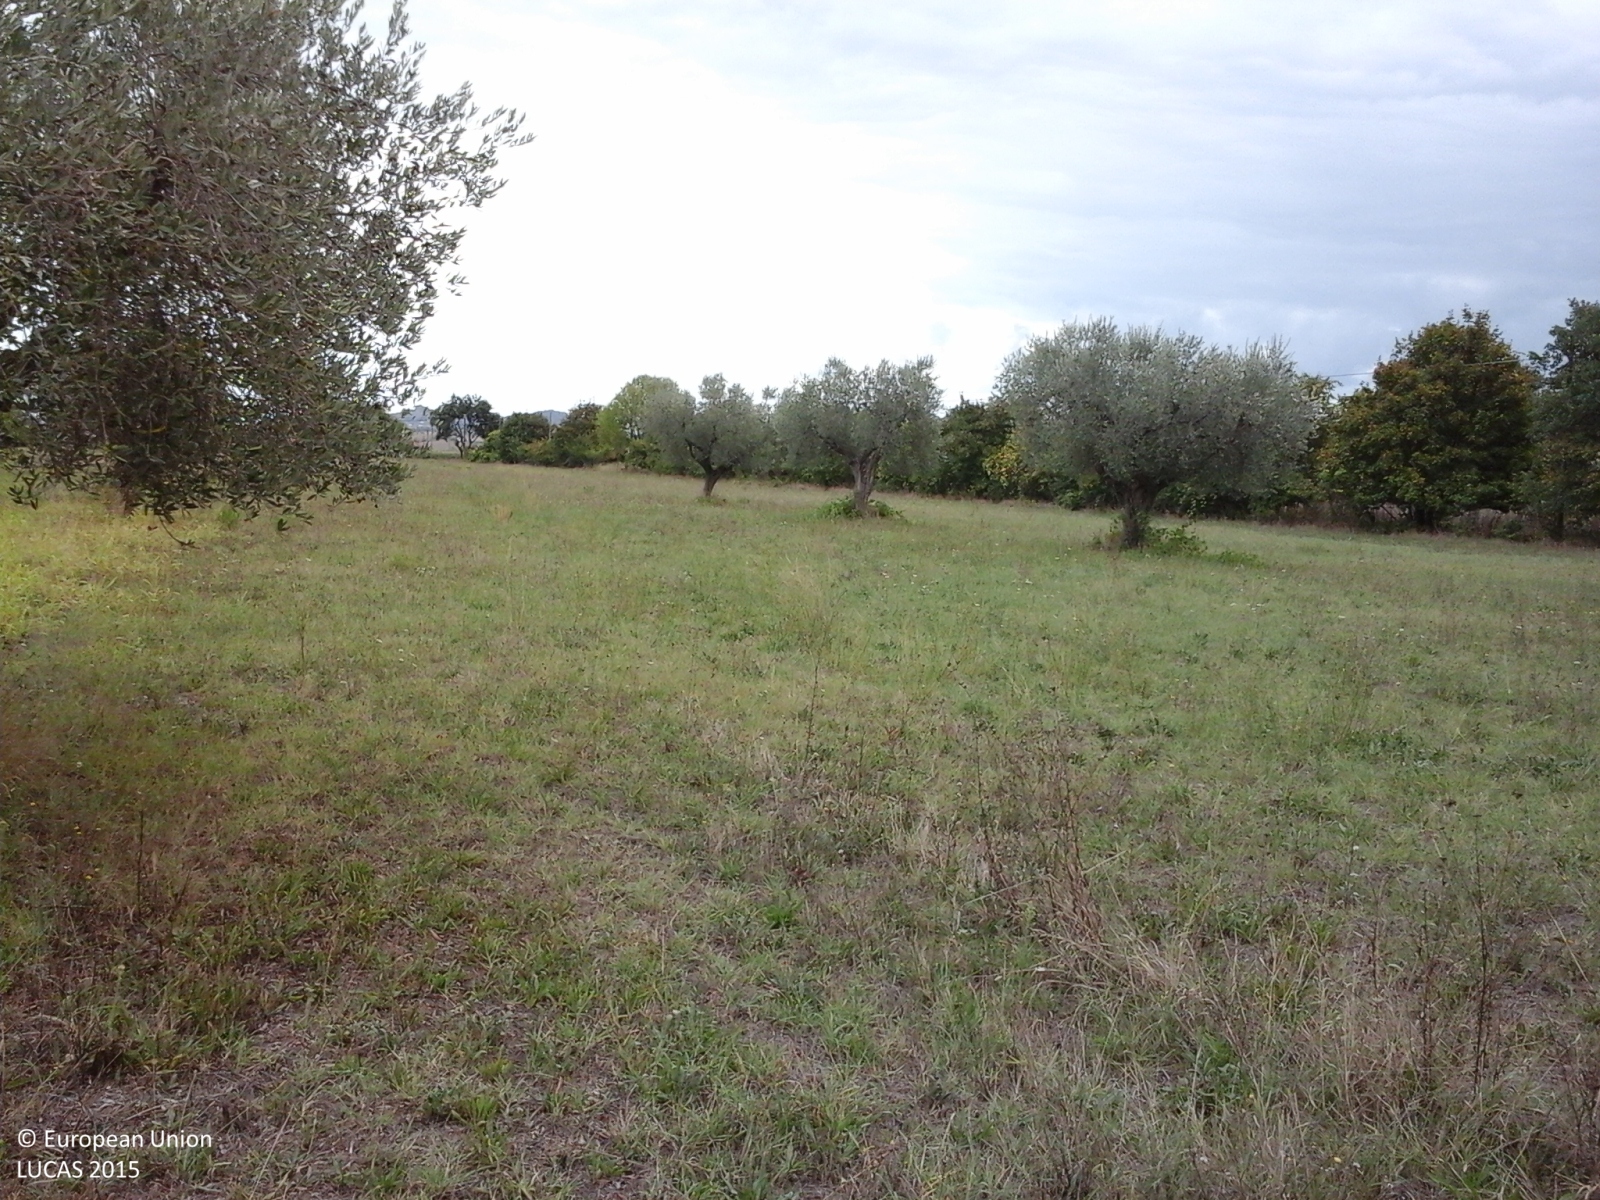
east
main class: Cropland
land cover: Olive groves
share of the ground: < 10 %
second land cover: Spontaneously vegetated surfaces
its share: > 75 %
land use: Agriculture (excluding fallow land and kitchen gardens)
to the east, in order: Olive groves; Spontaneously vegetated surfaces; Olive groves; Spontaneously vegetated surfaces; Managed hedges; Electric lines; Grassland without tree/shrub cover; Single bushes/trees; Grassland without tree/shrub cover
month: September
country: IT
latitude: 42.7991
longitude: 13.8163
